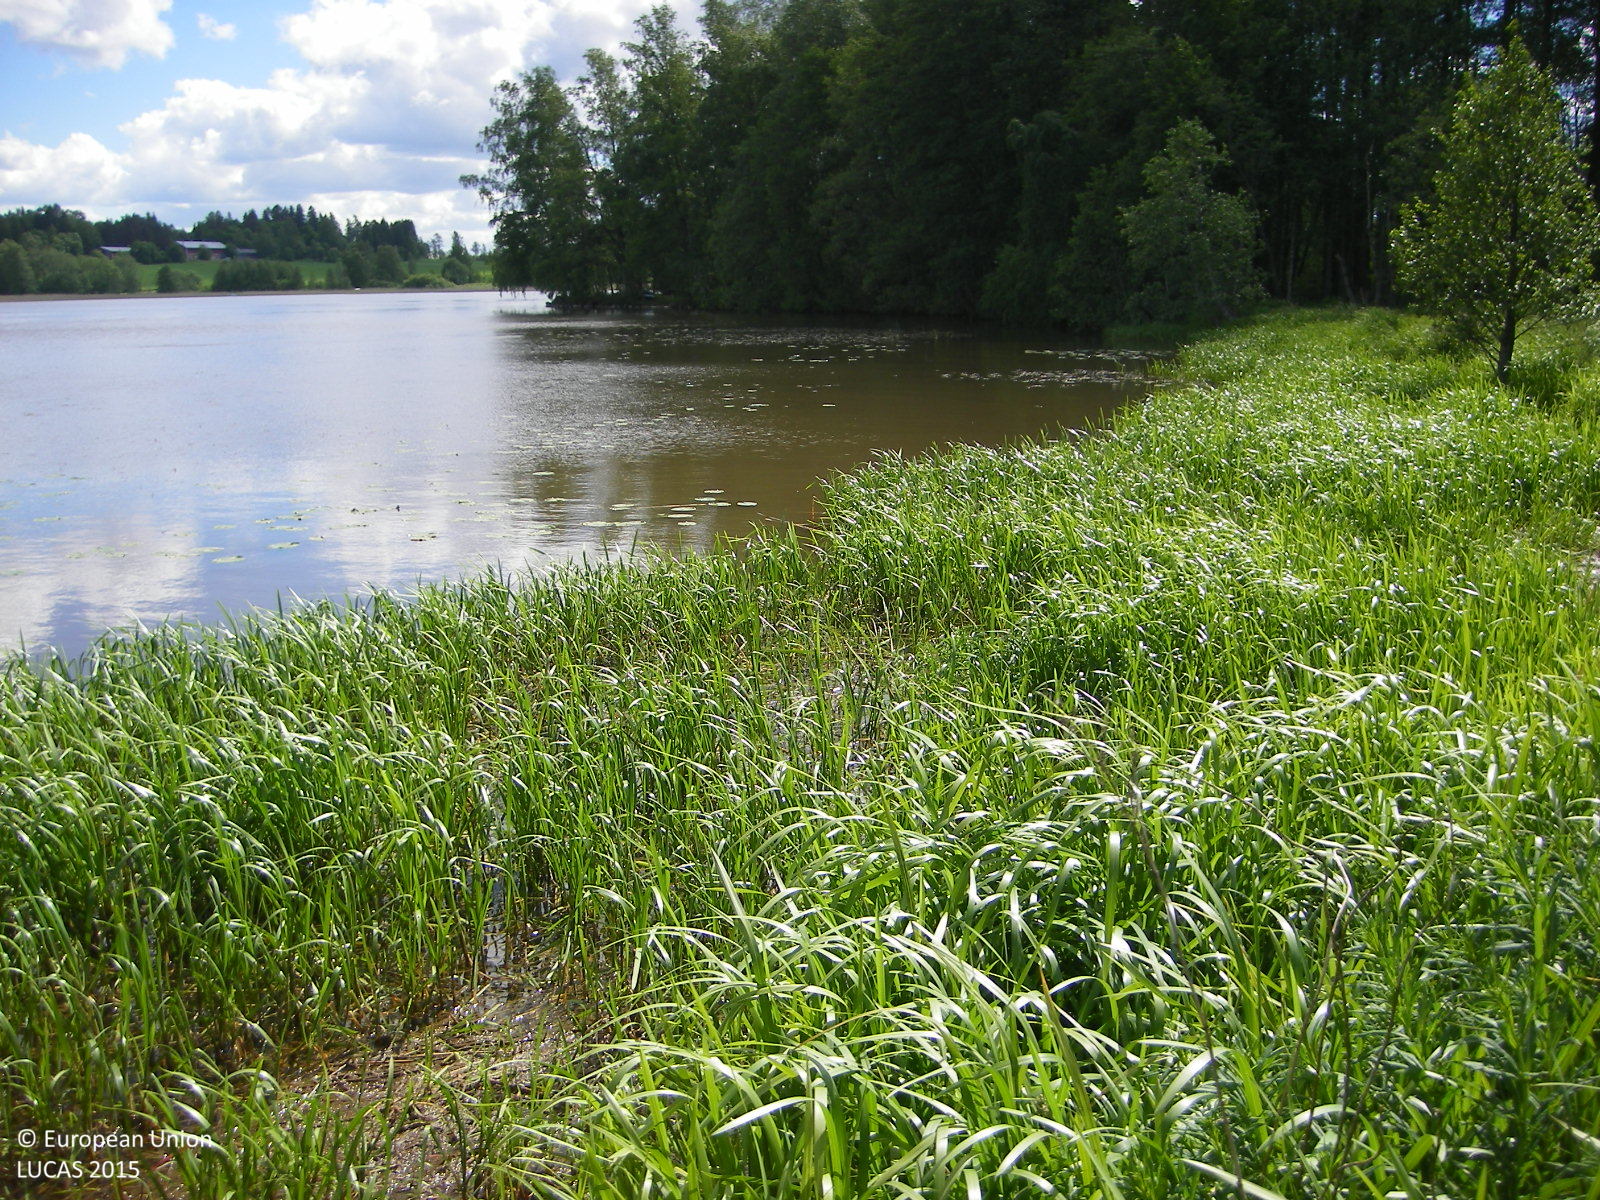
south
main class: Grassland
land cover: Spontaneously vegetated surfaces
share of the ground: > 75 %
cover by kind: herbaceous plants 100 %
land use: Semi-natural and natural areas not in use
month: June
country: FI
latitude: 60.3432
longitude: 24.1416
